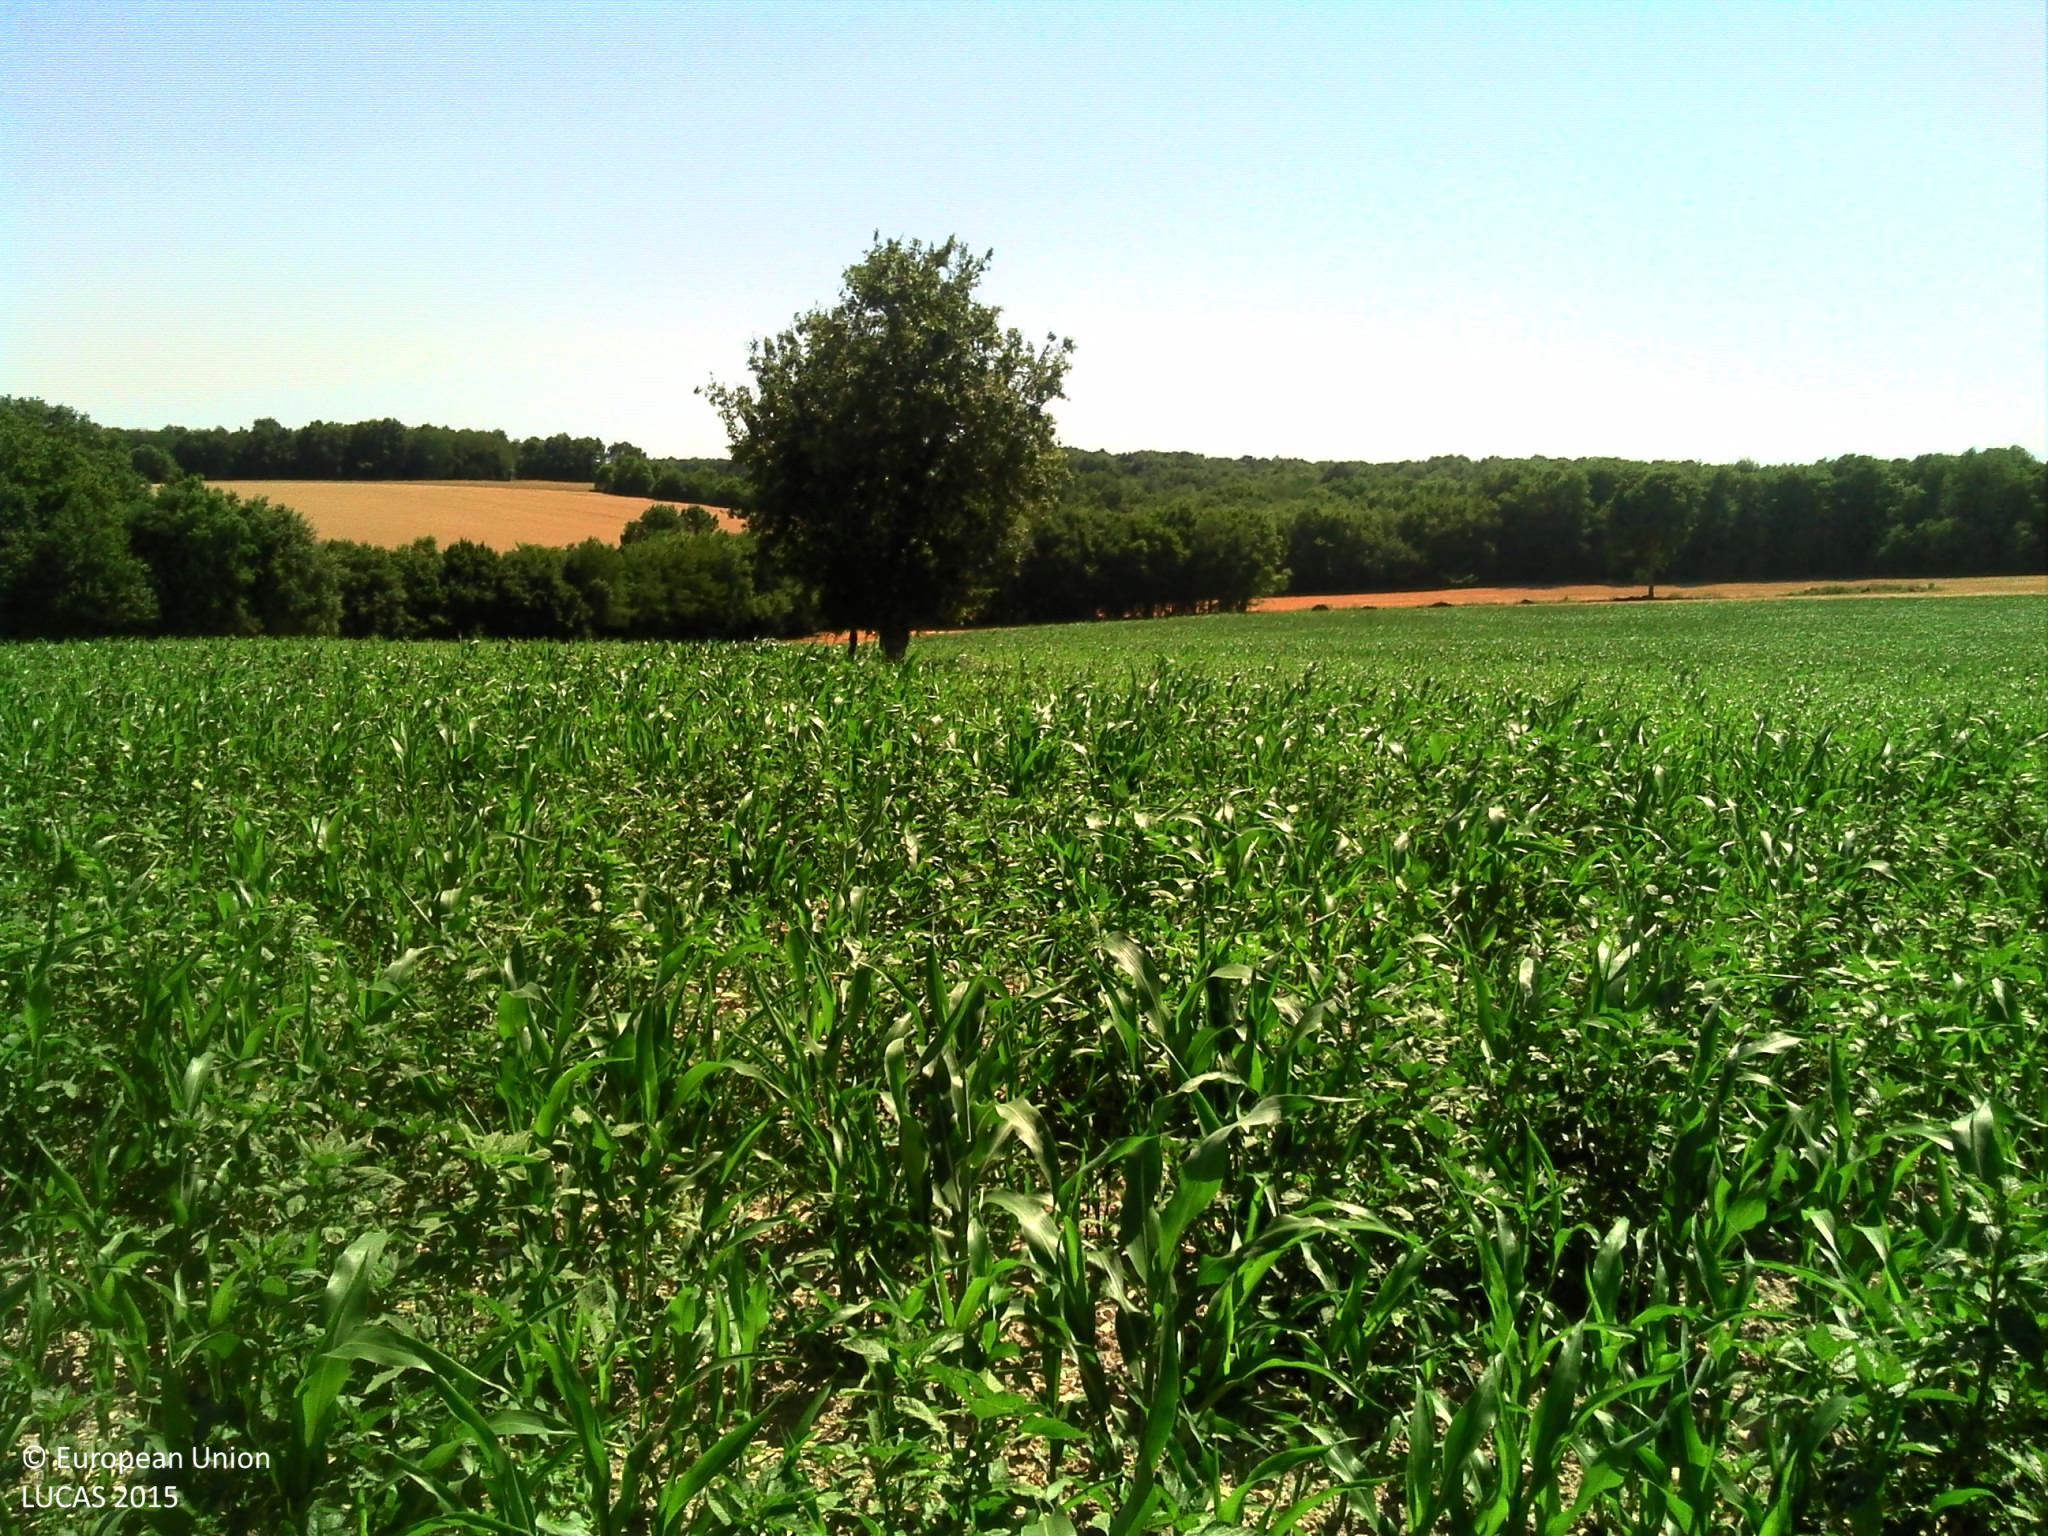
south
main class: Cropland
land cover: Maize
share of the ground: 25 - 50 %
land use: Agriculture (excluding fallow land and kitchen gardens)
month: July
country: FR
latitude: 47.2357
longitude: 0.5353
